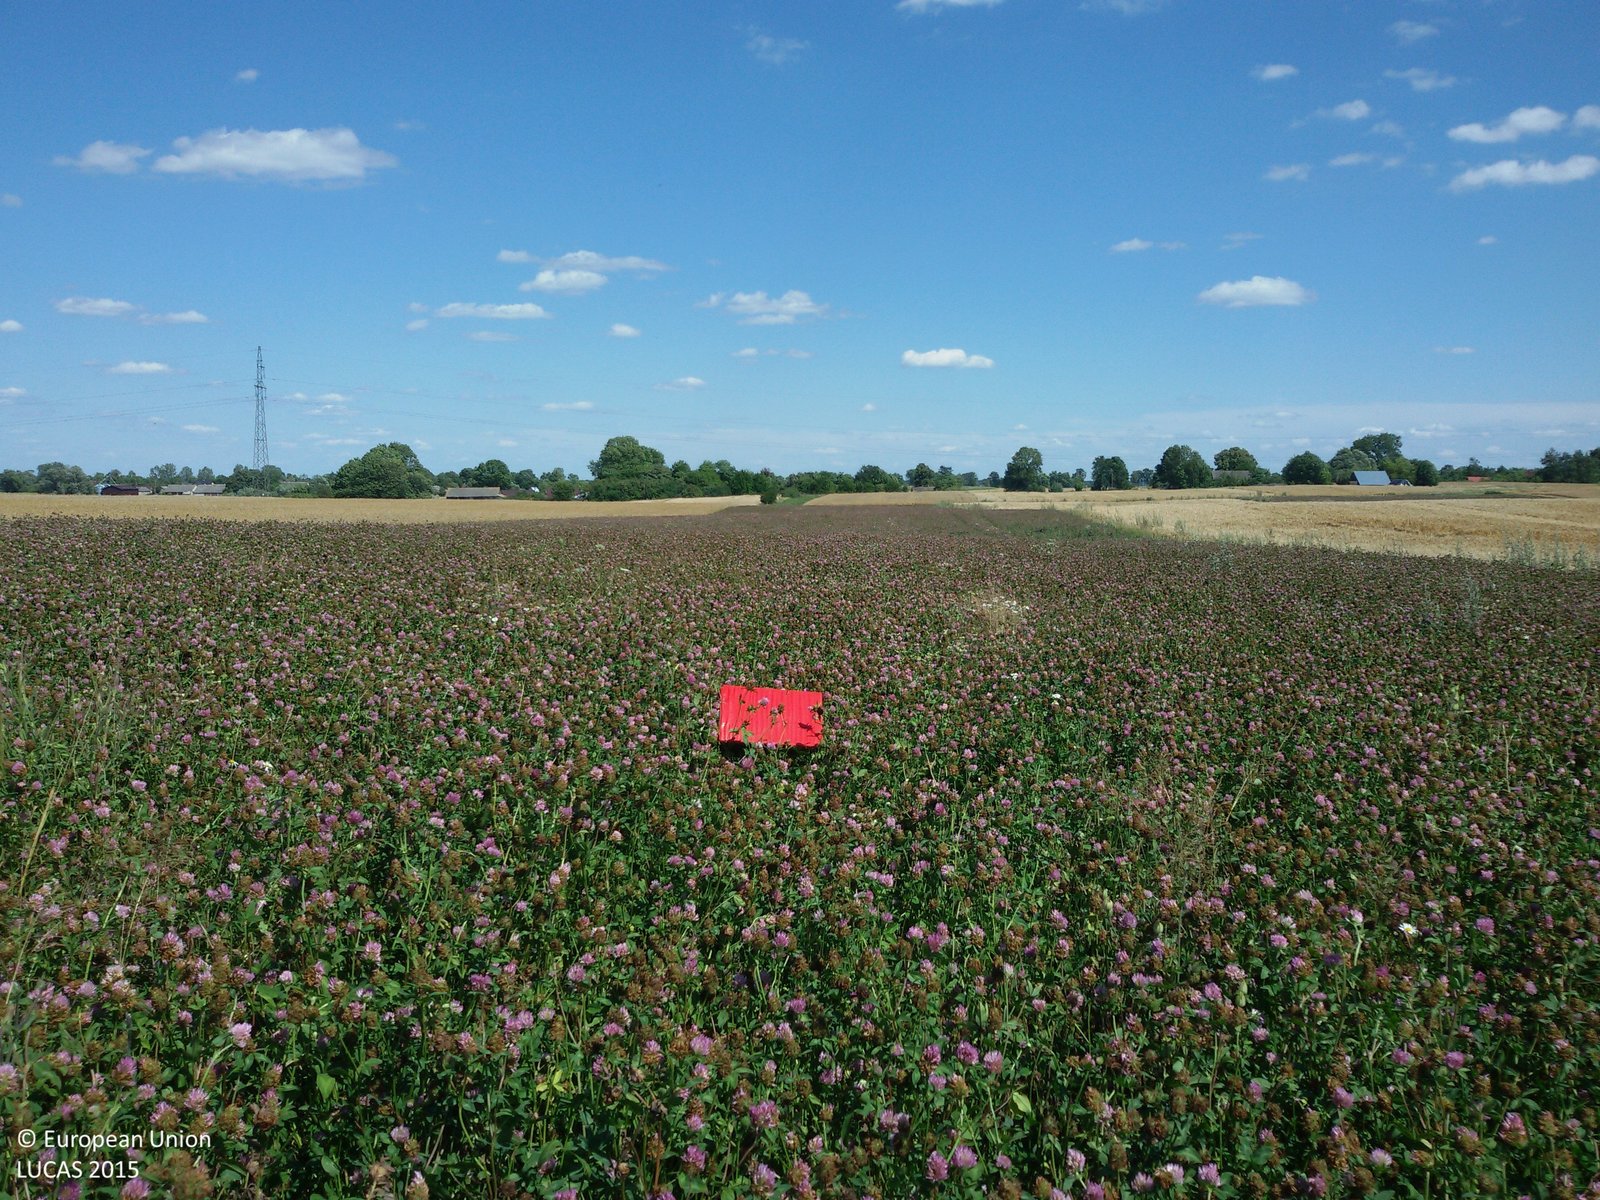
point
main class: Cropland
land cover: Clovers
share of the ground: > 75 %
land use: Agriculture (excluding fallow land and kitchen gardens)
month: July
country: PL
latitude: 51.2285
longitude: 23.4150
